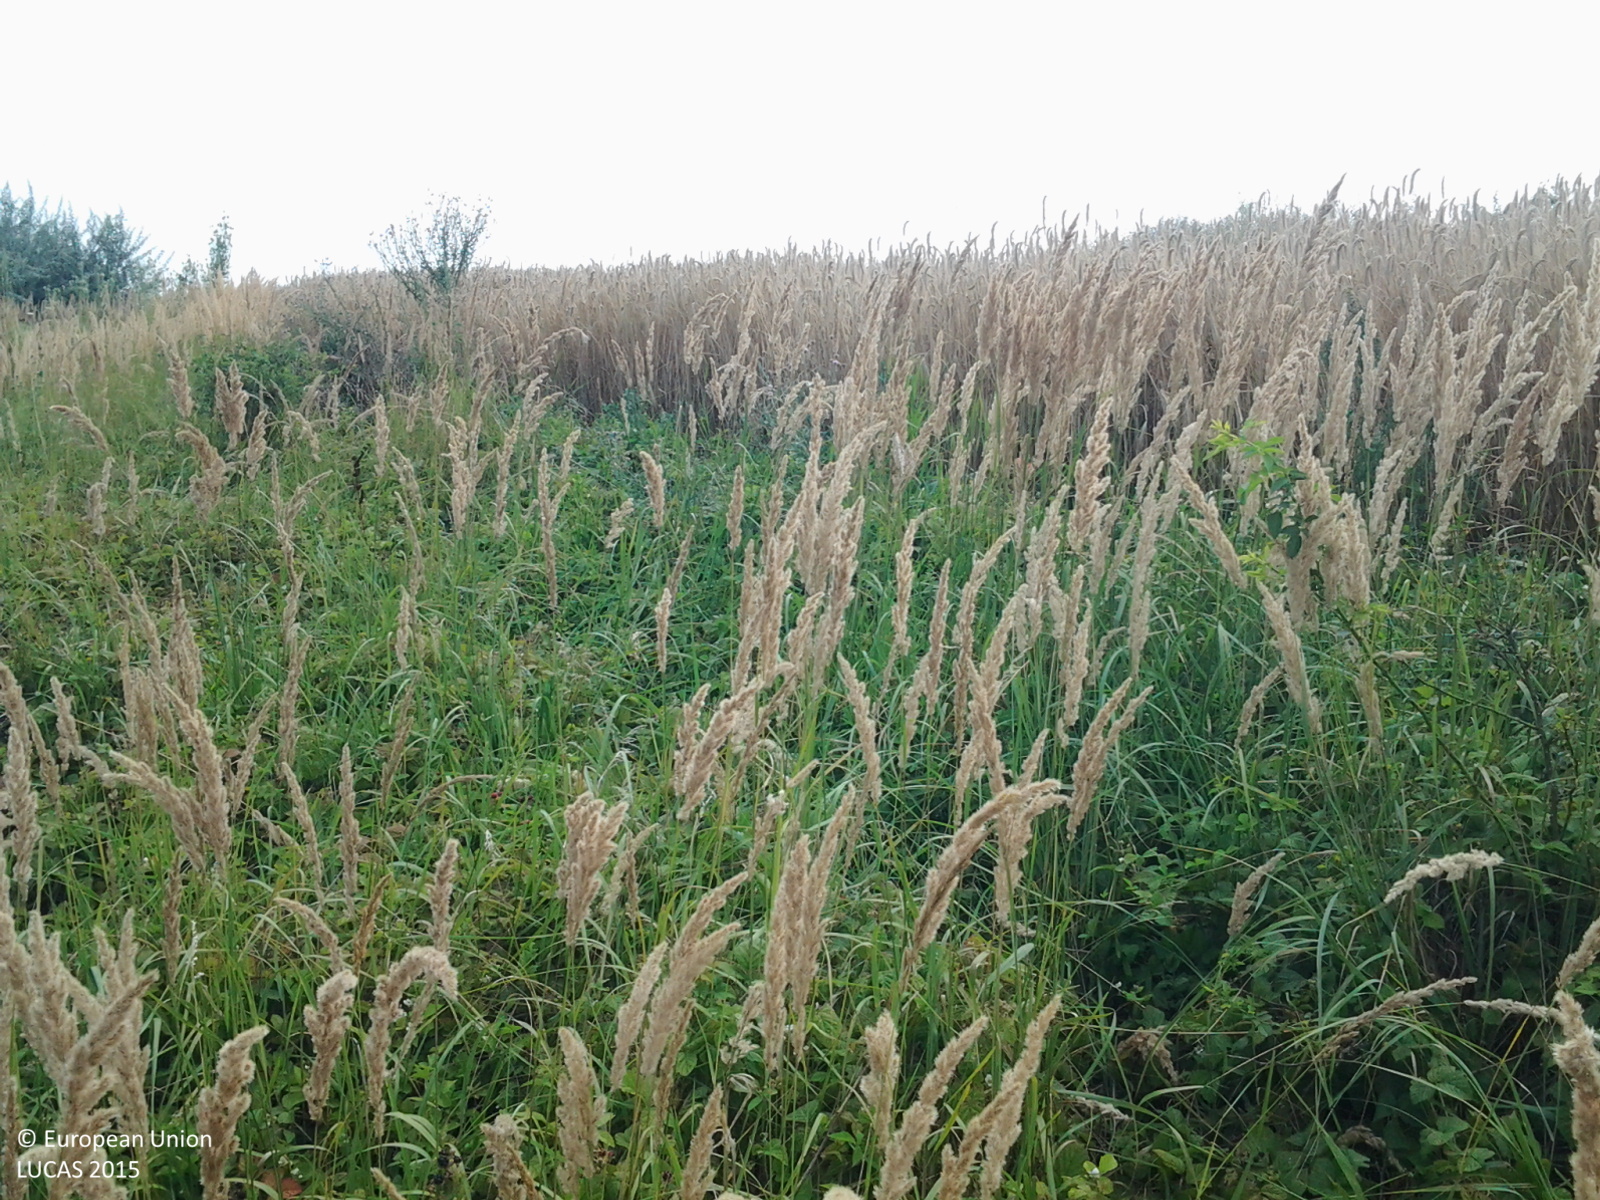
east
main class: Grassland
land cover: Grassland with sparse tree/shrub cover
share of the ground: > 75 %
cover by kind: herbaceous plants 85 %, shrubs 10 %, broadleaved forest trees 5 %
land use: Semi-natural and natural areas not in use
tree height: < 5 m
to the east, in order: Grassland with sparse tree/shrub cover; Triticale; Grass margins; Common wheat; Maize; Grass margins; Ditches and canals; Grass margins; Maize
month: July
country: HU
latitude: 47.1083
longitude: 20.4524
